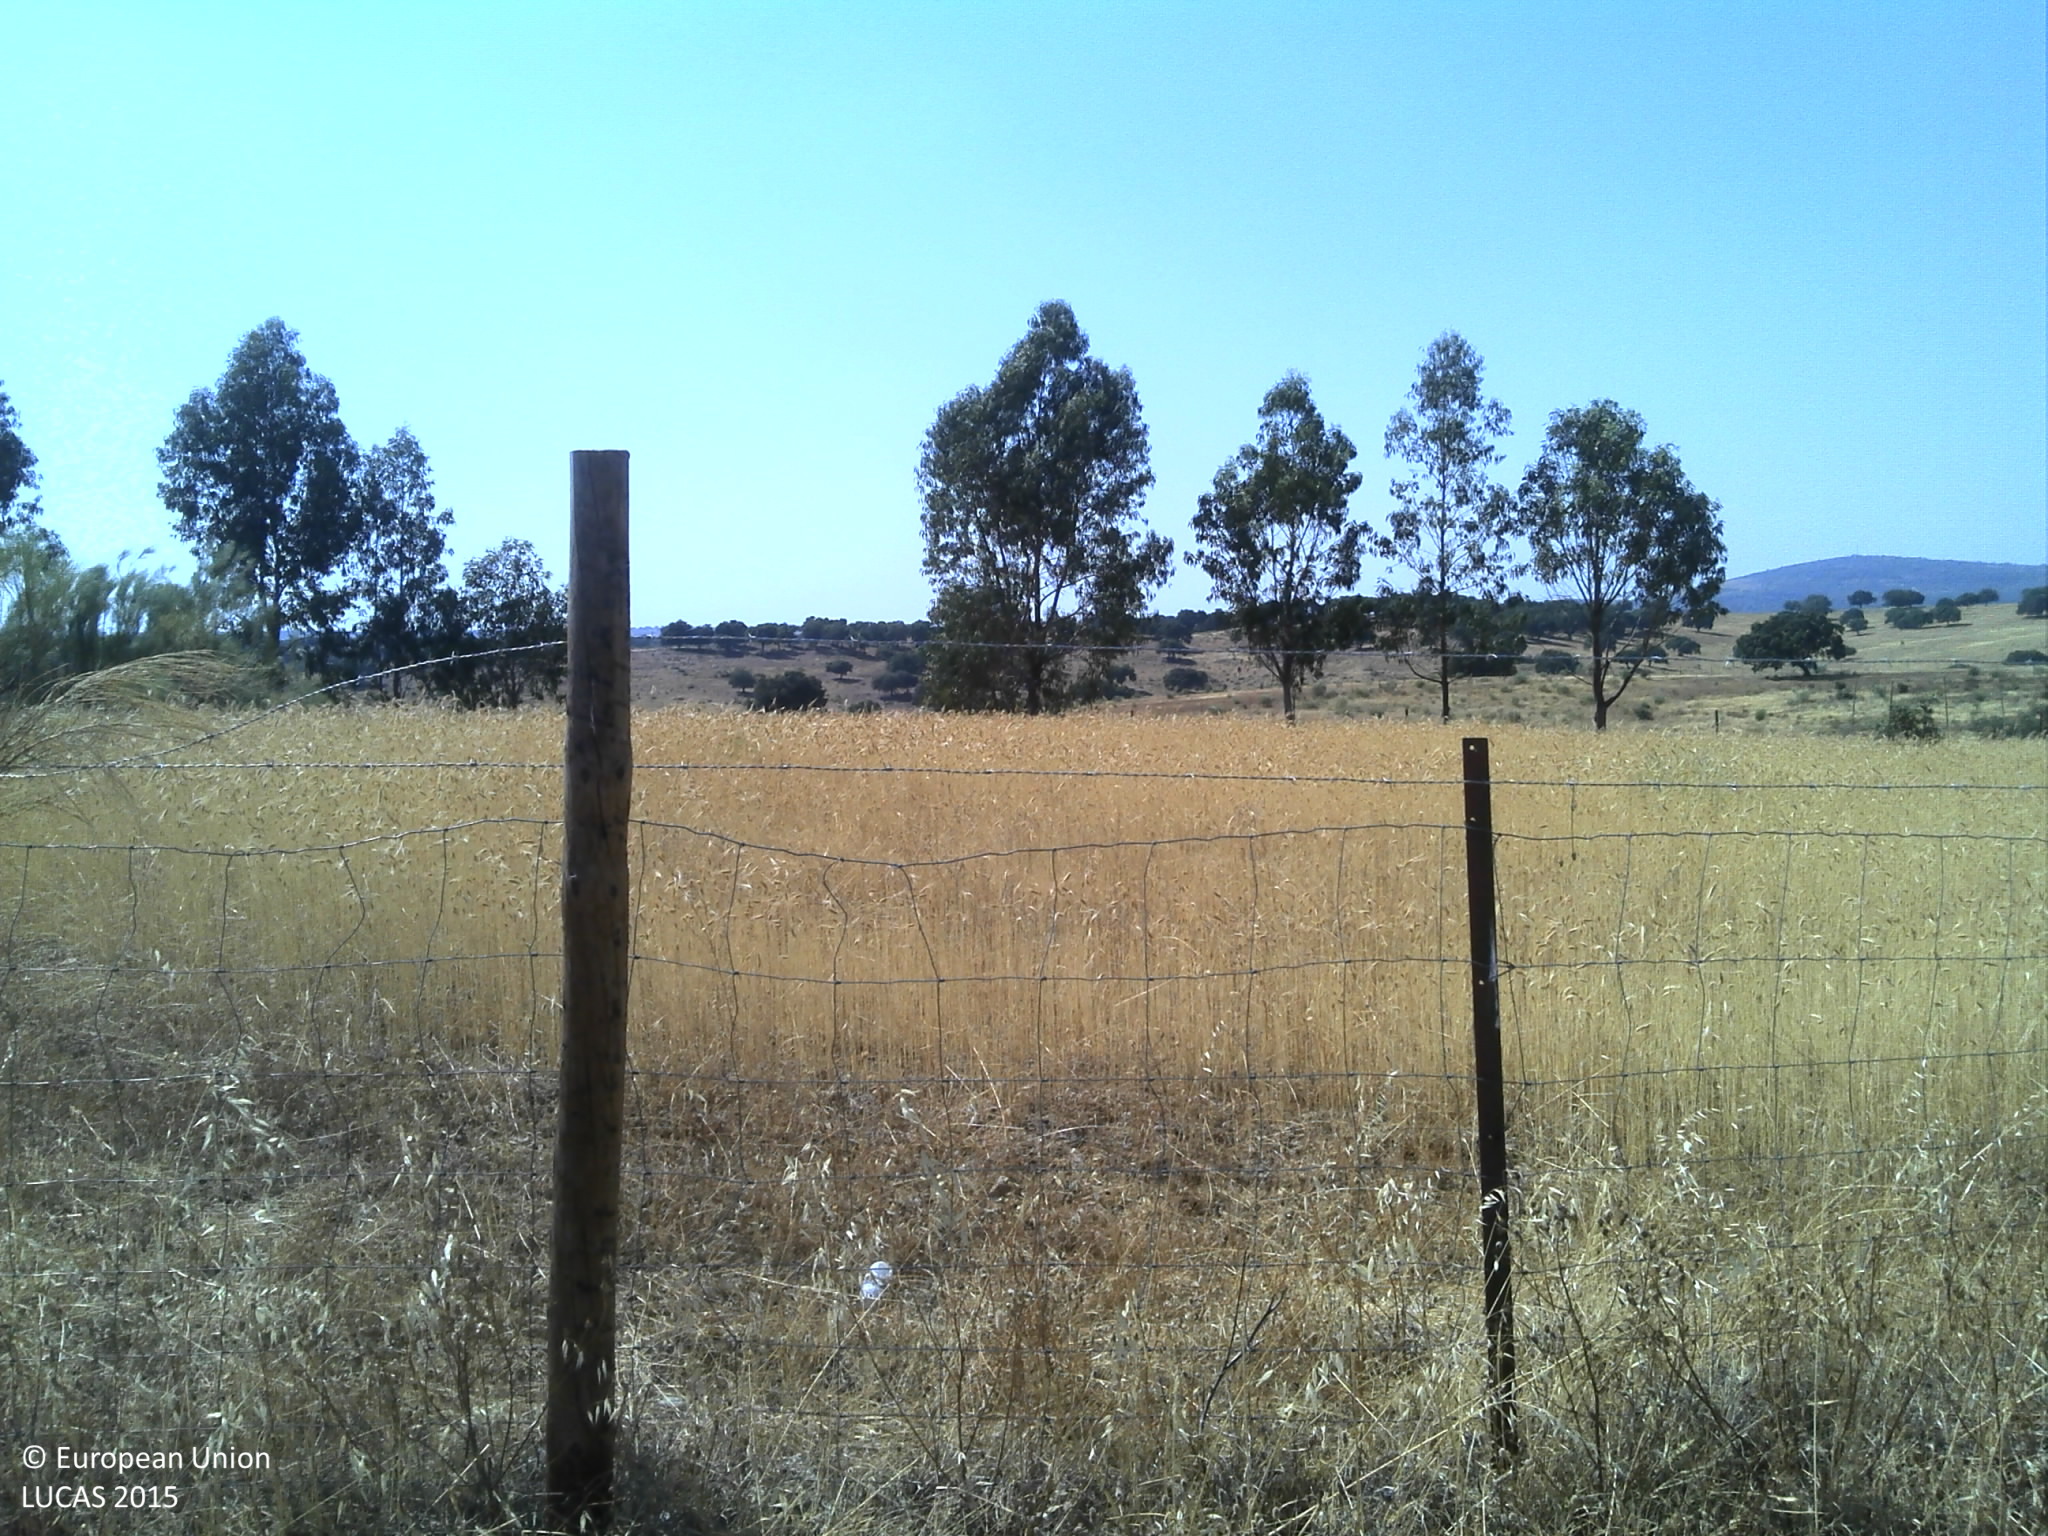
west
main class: Woodland
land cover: Broadleaved woodland
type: broadleaved evergreen forest
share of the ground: 25 - 50 %
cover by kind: herbaceous plants 70 %, broadleaved forest trees 30 %
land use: Forestry
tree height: > 5 m
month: June
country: PT
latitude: 39.6789
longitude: -7.2884
